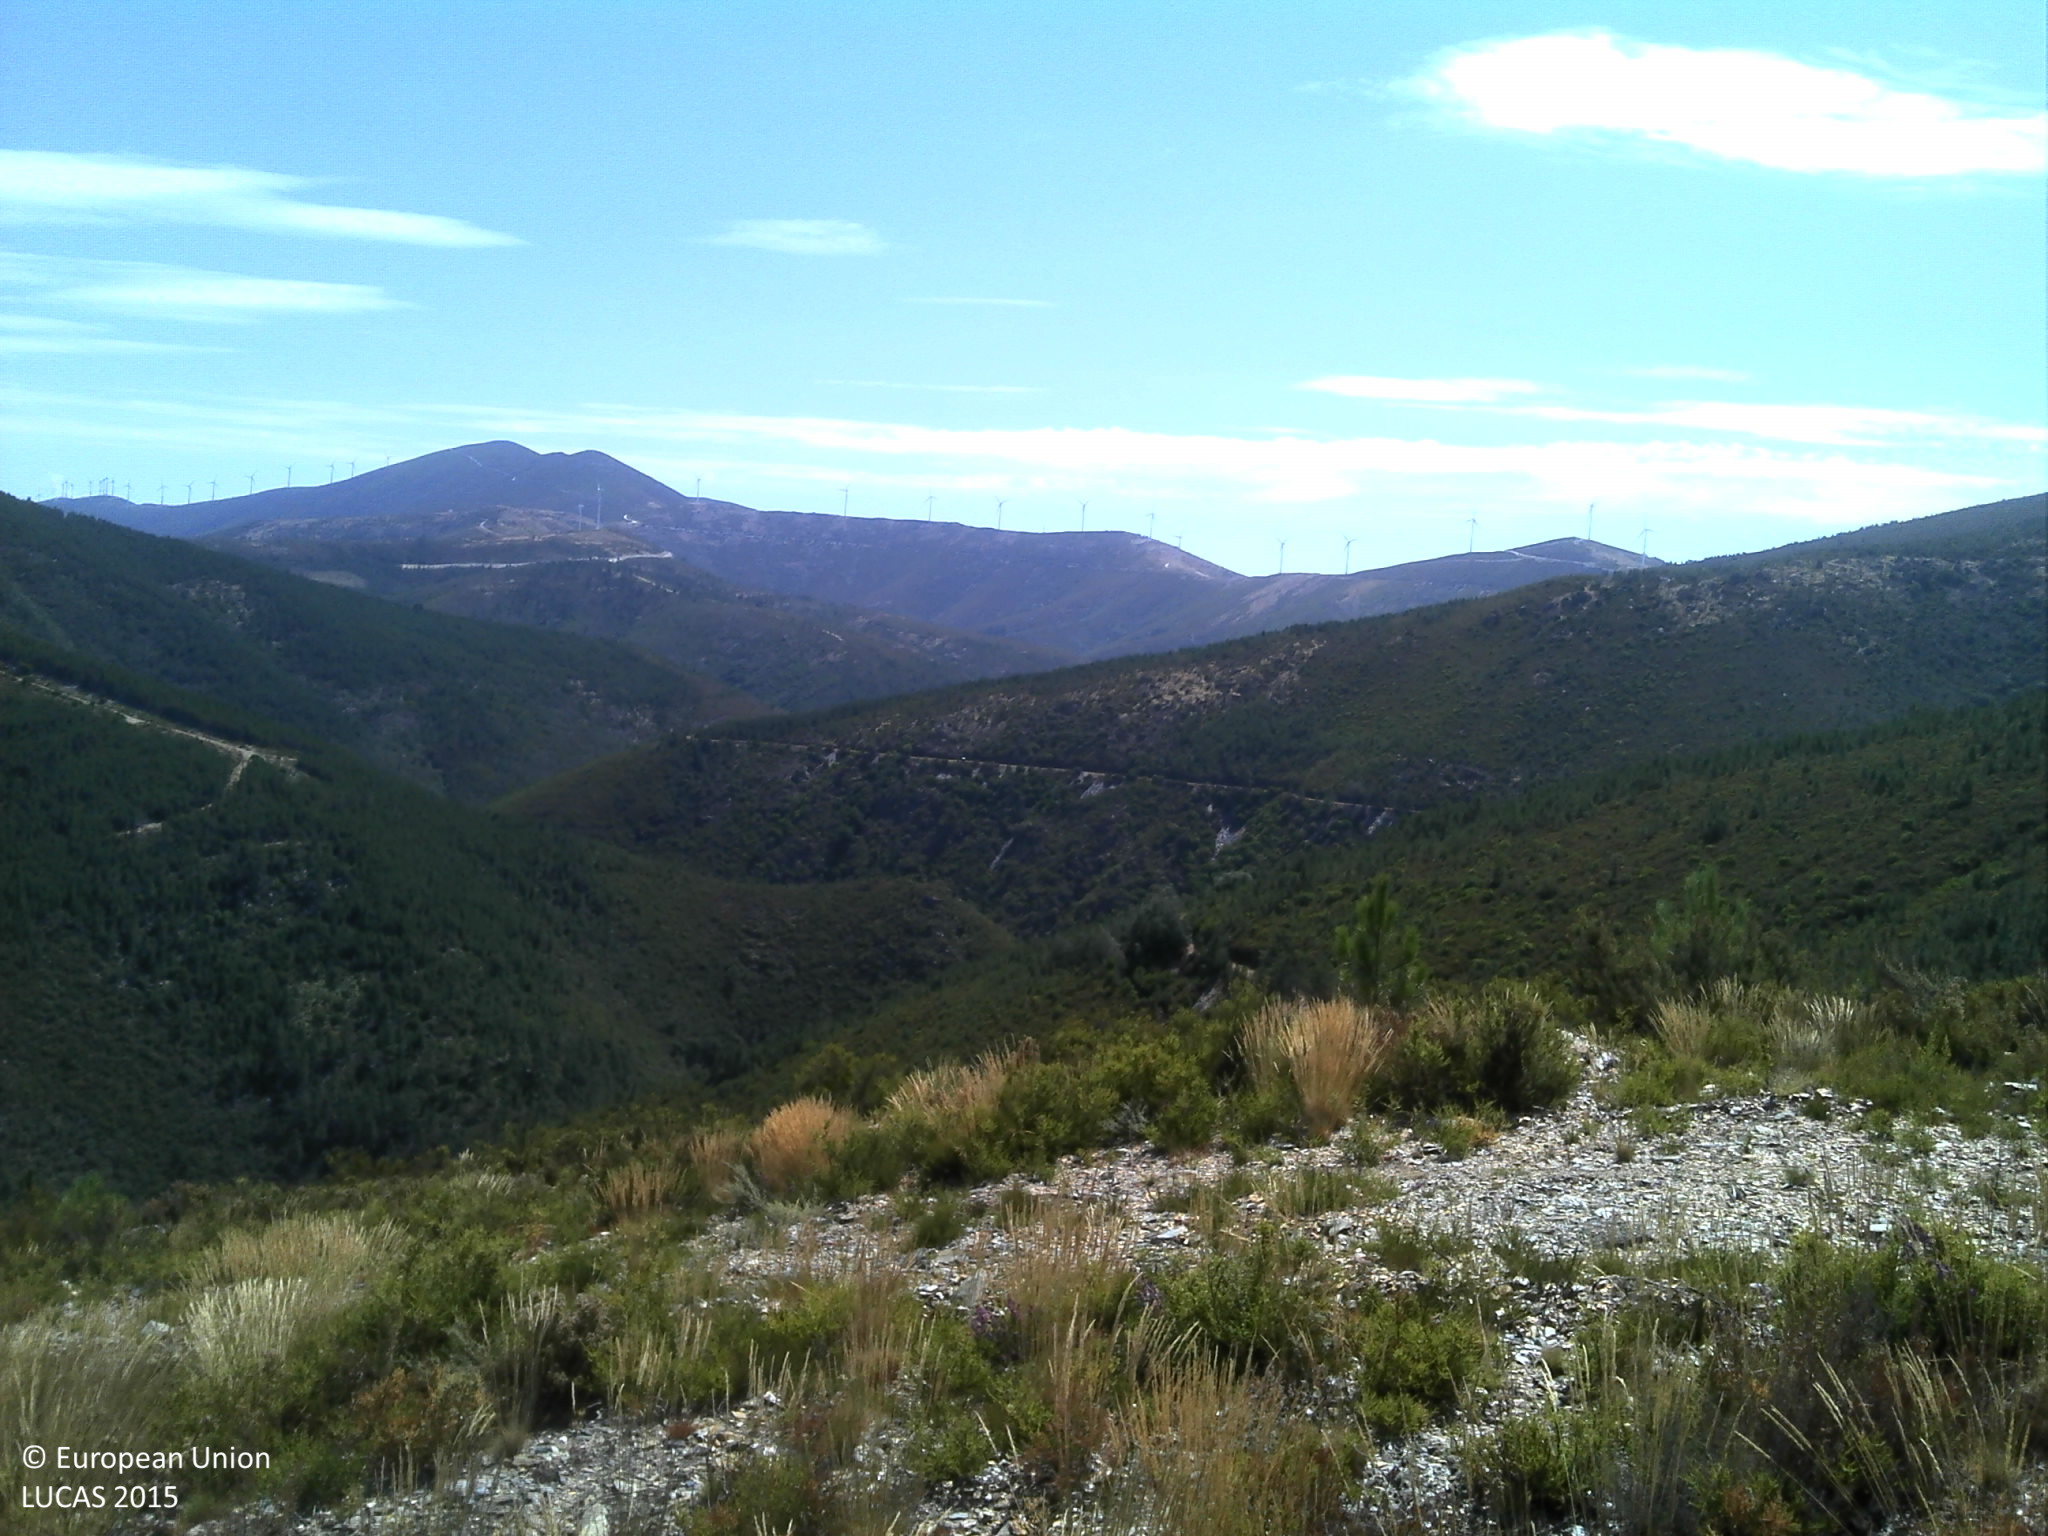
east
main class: Shrubland
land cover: Shrubland without tree cover
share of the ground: > 75 %
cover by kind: shrubs 90 %, unconsolidated bare surface 10 %
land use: Semi-natural and natural areas not in use
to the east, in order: Shrubland without tree cover
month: July
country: PT
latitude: 40.1575
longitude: -7.9018
